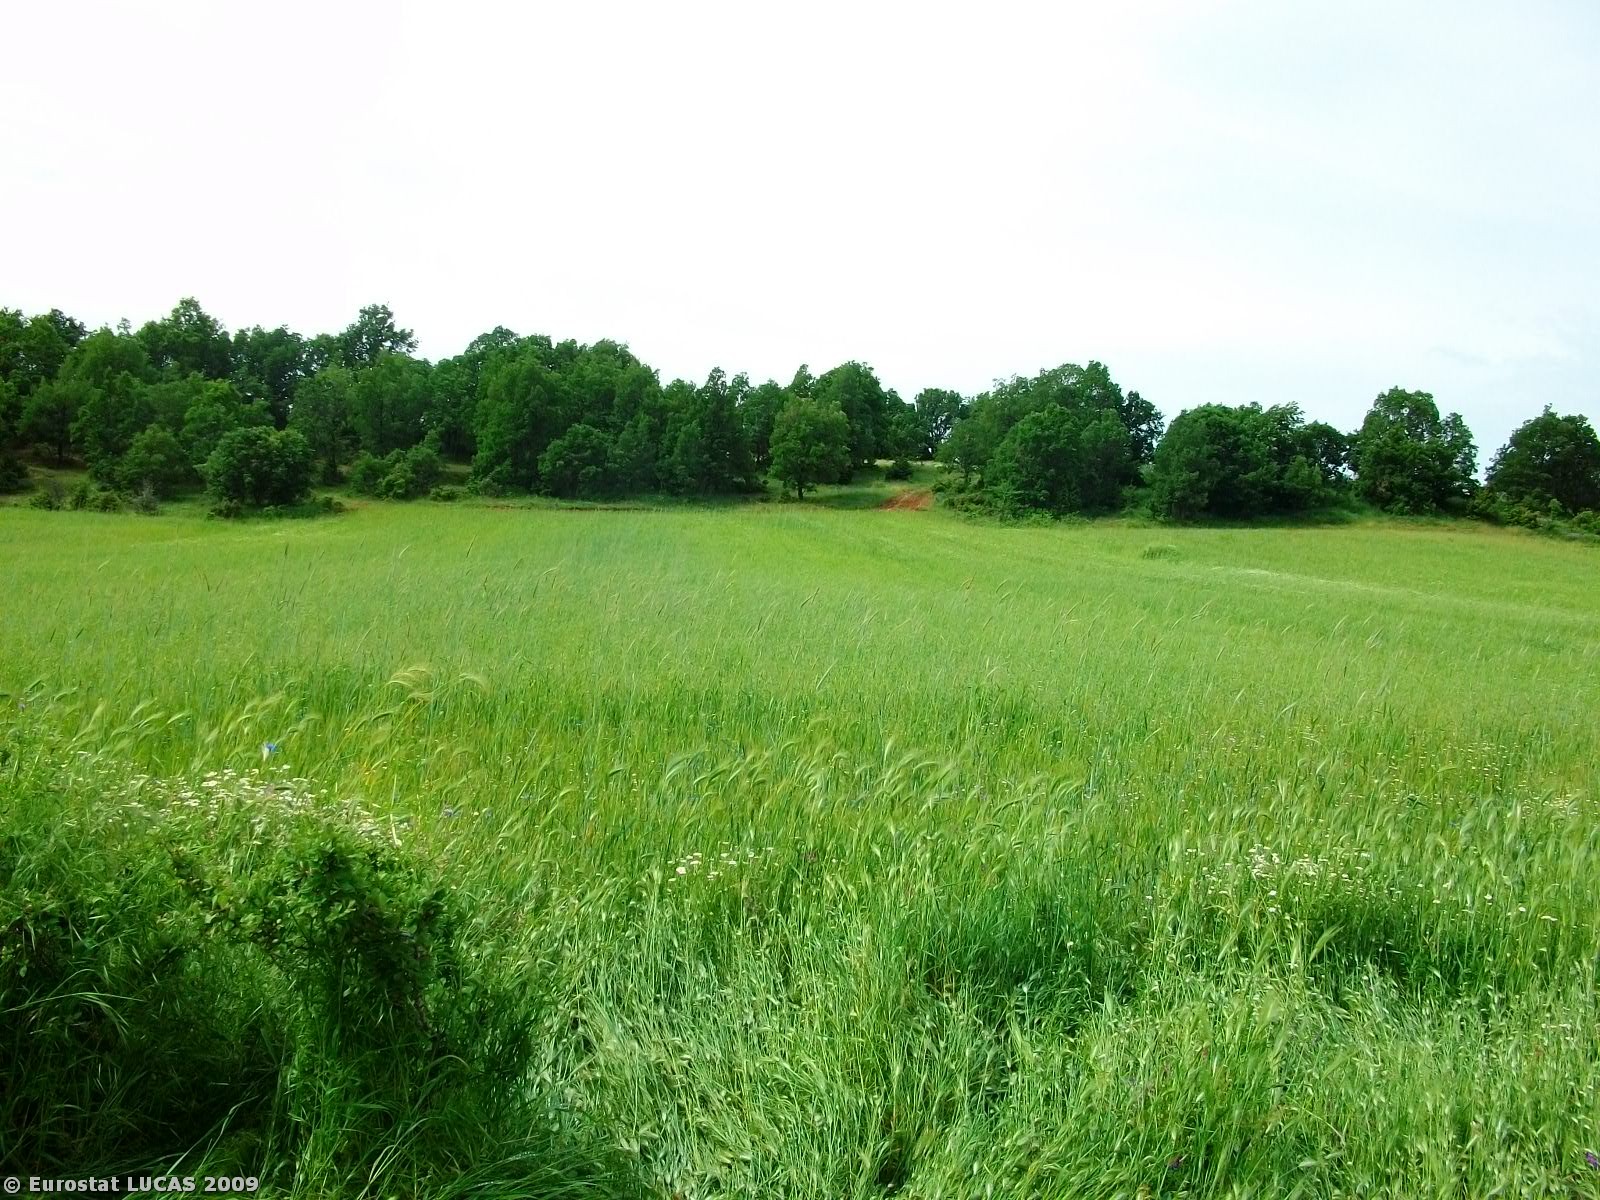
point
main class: Cropland
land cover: Barley
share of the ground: > 75 %
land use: Agriculture (excluding fallow land and kitchen gardens)
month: May
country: GR
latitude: 40.7128
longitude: 21.8697
